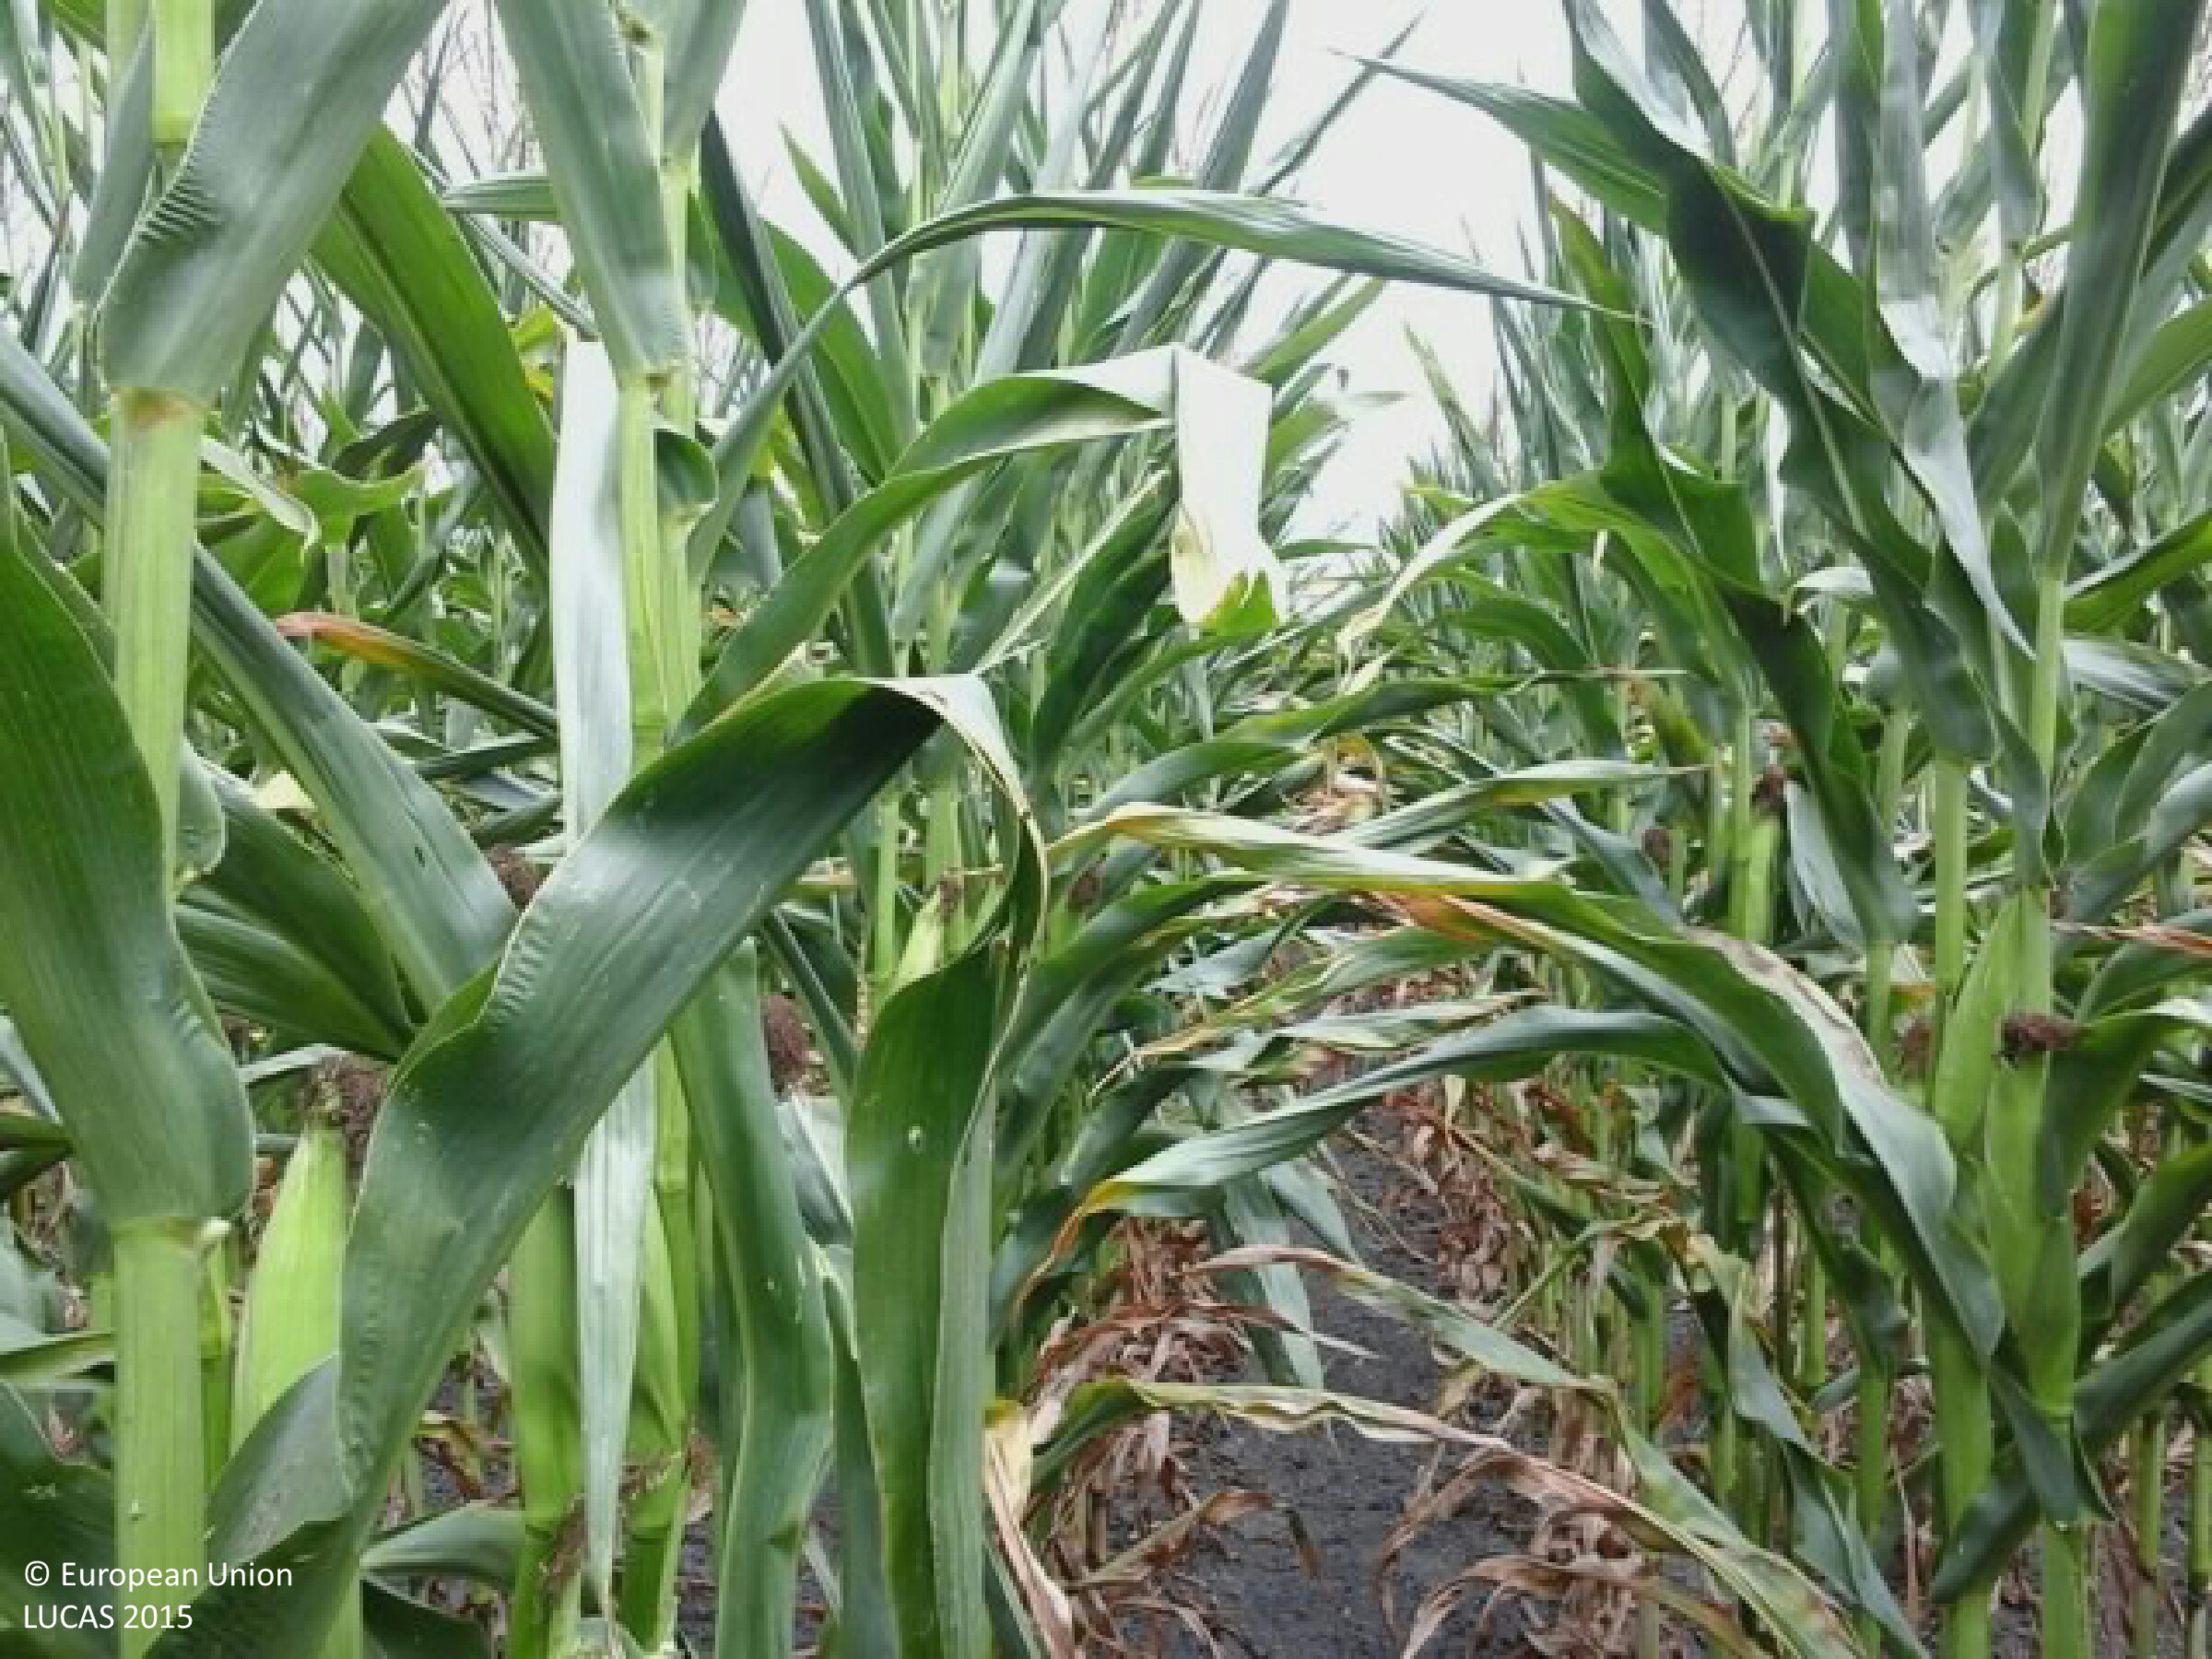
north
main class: Cropland
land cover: Maize
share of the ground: > 75 %
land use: Agriculture (excluding fallow land and kitchen gardens)
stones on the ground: < 10 %
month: July
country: HU
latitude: 46.2223
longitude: 18.8141
